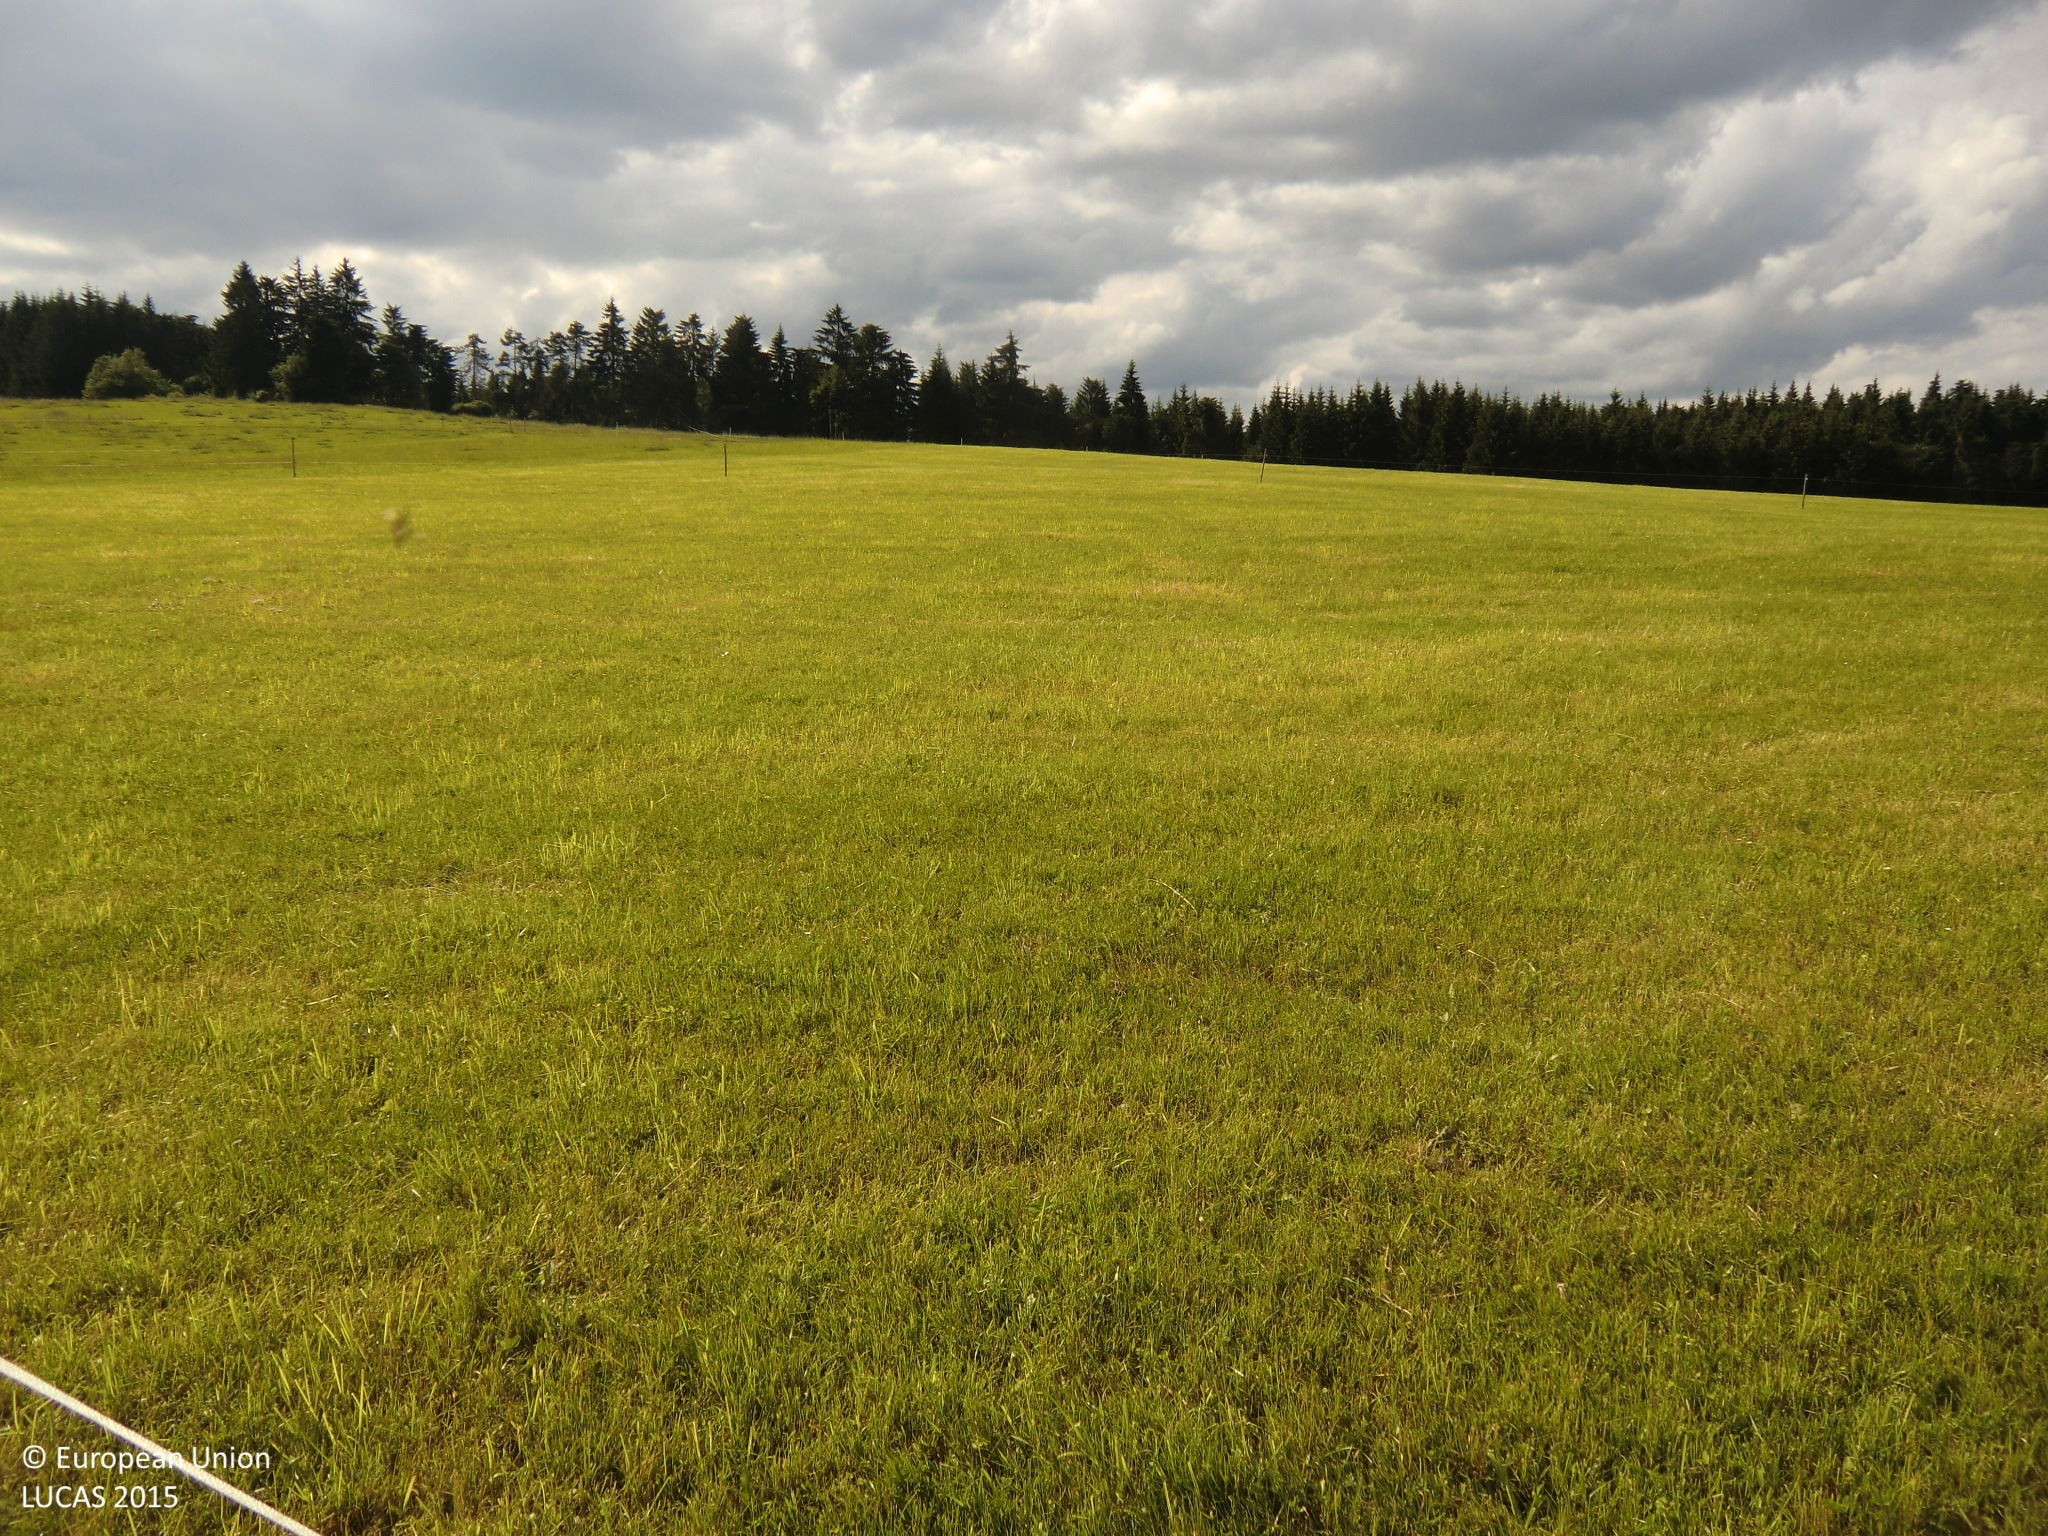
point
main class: Grassland
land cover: Grassland without tree/shrub cover
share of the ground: > 75 %
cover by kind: herbaceous plants 100 %
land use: Agriculture (excluding fallow land and kitchen gardens)
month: June
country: AT
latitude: 48.5141
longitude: 14.8342
